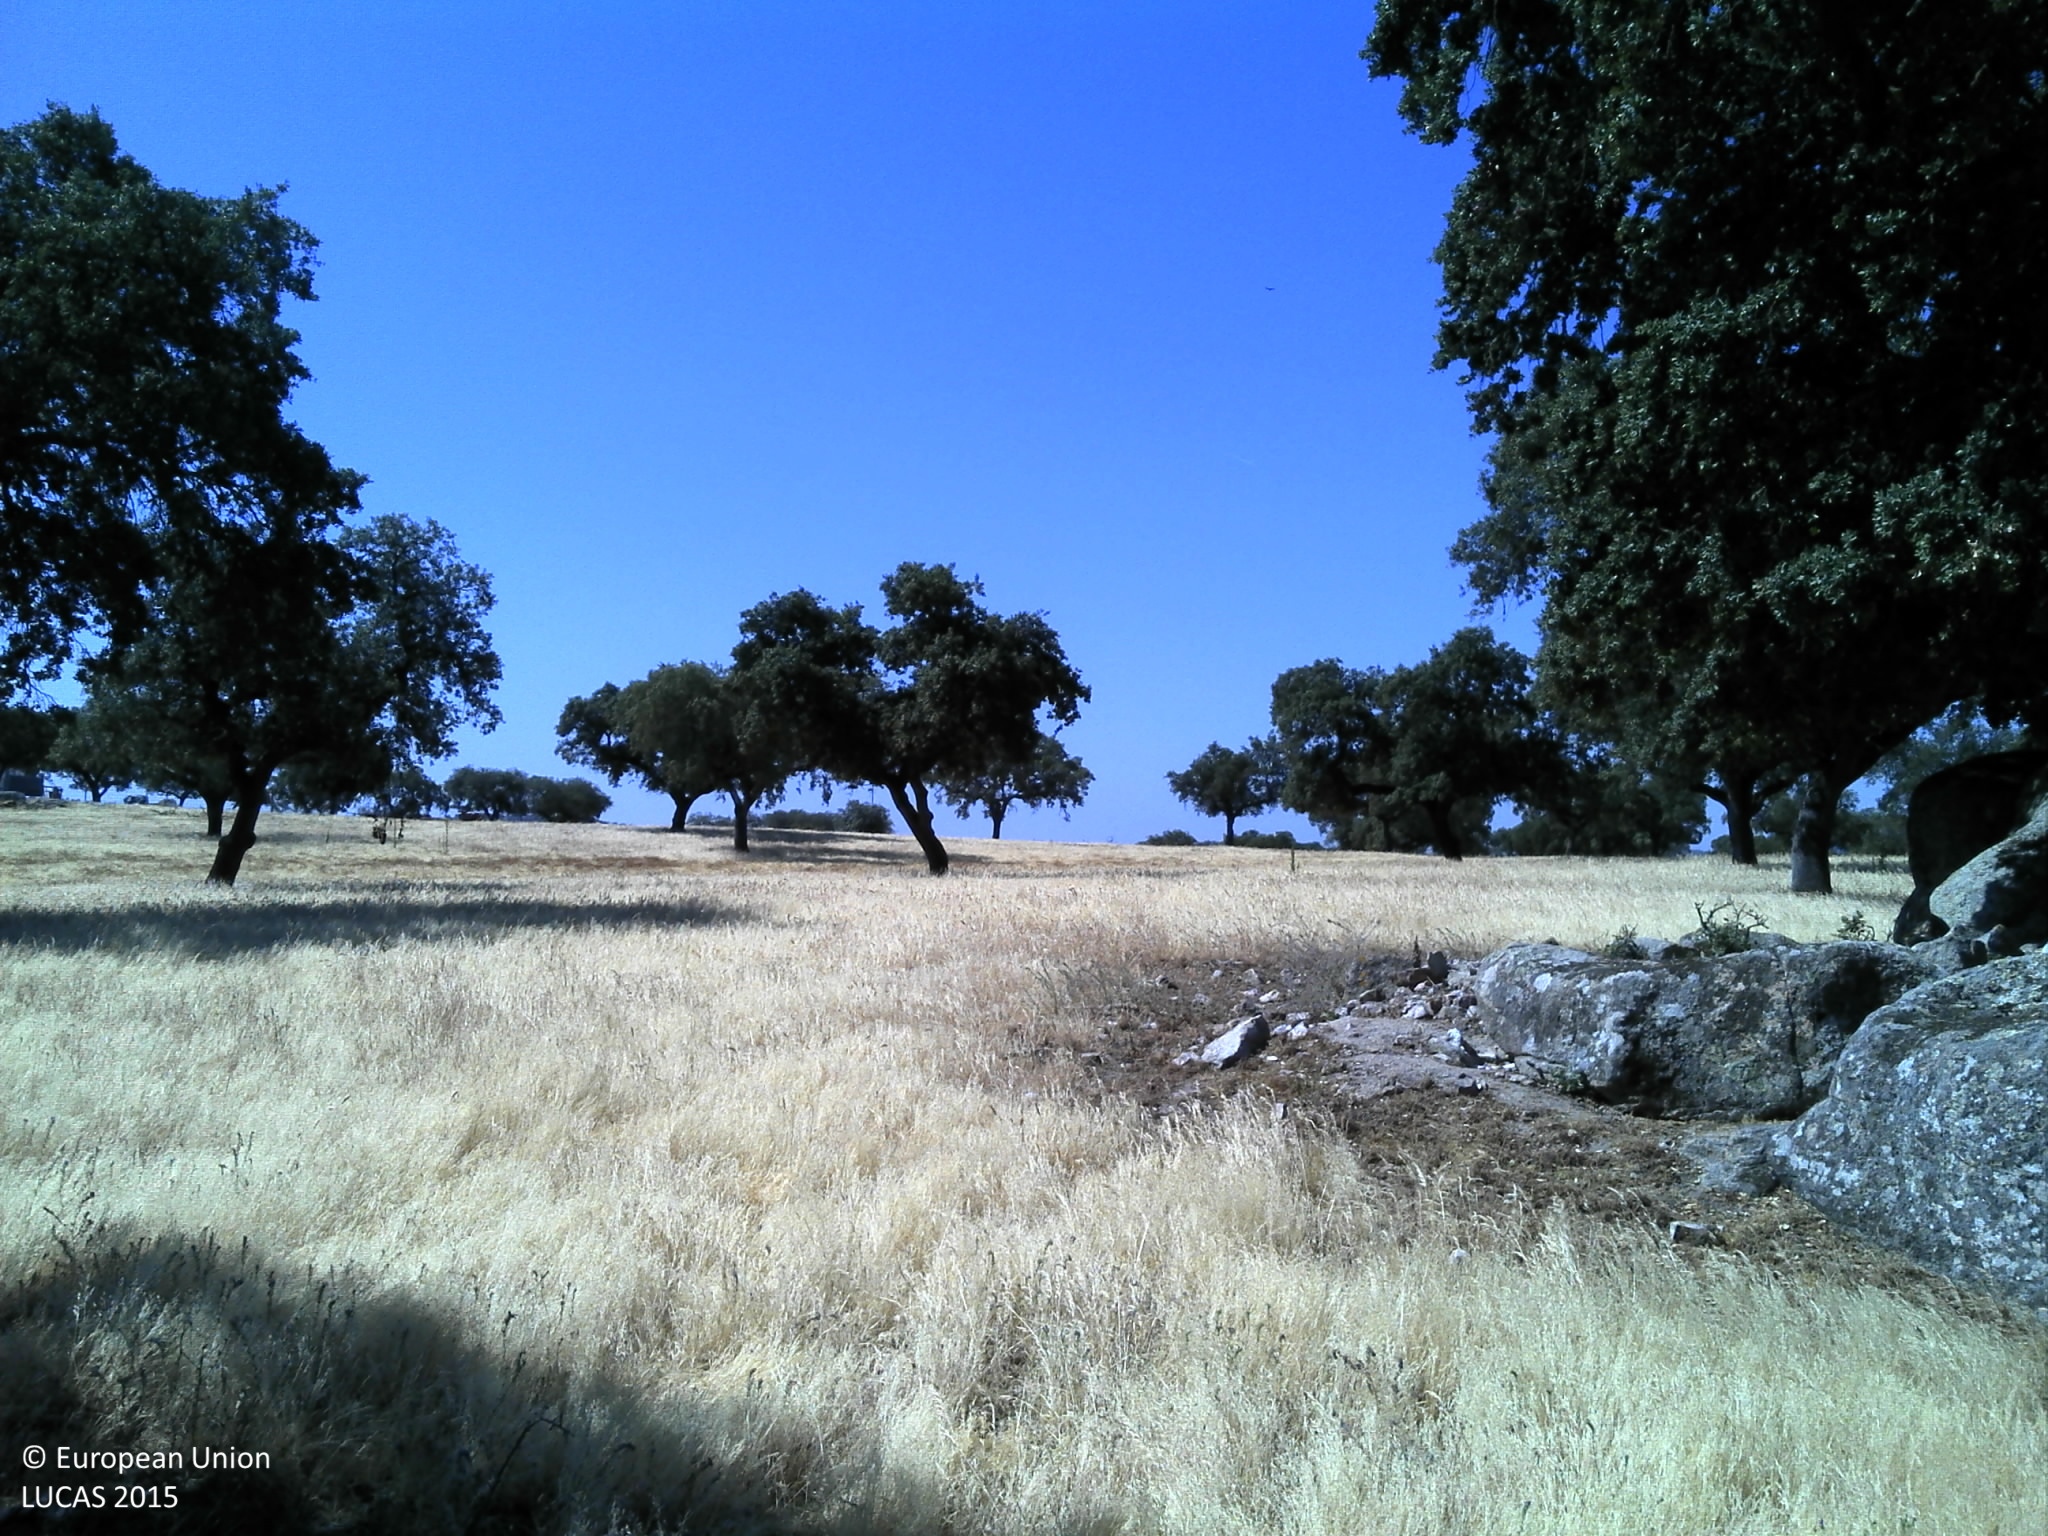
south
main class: Woodland
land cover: Broadleaved woodland
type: broadleaved evergreen forest
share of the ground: 10 - 25 %
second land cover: Grassland without tree/shrub cover
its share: 50 - 75 %
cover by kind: herbaceous plants 60 %, broadleaved forest trees 30 %, consolidated bare surface 10 %
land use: Forestry
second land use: Agriculture (excluding fallow land and kitchen gardens)
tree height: > 5 m
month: June
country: PT
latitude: 38.8610
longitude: -7.9193
